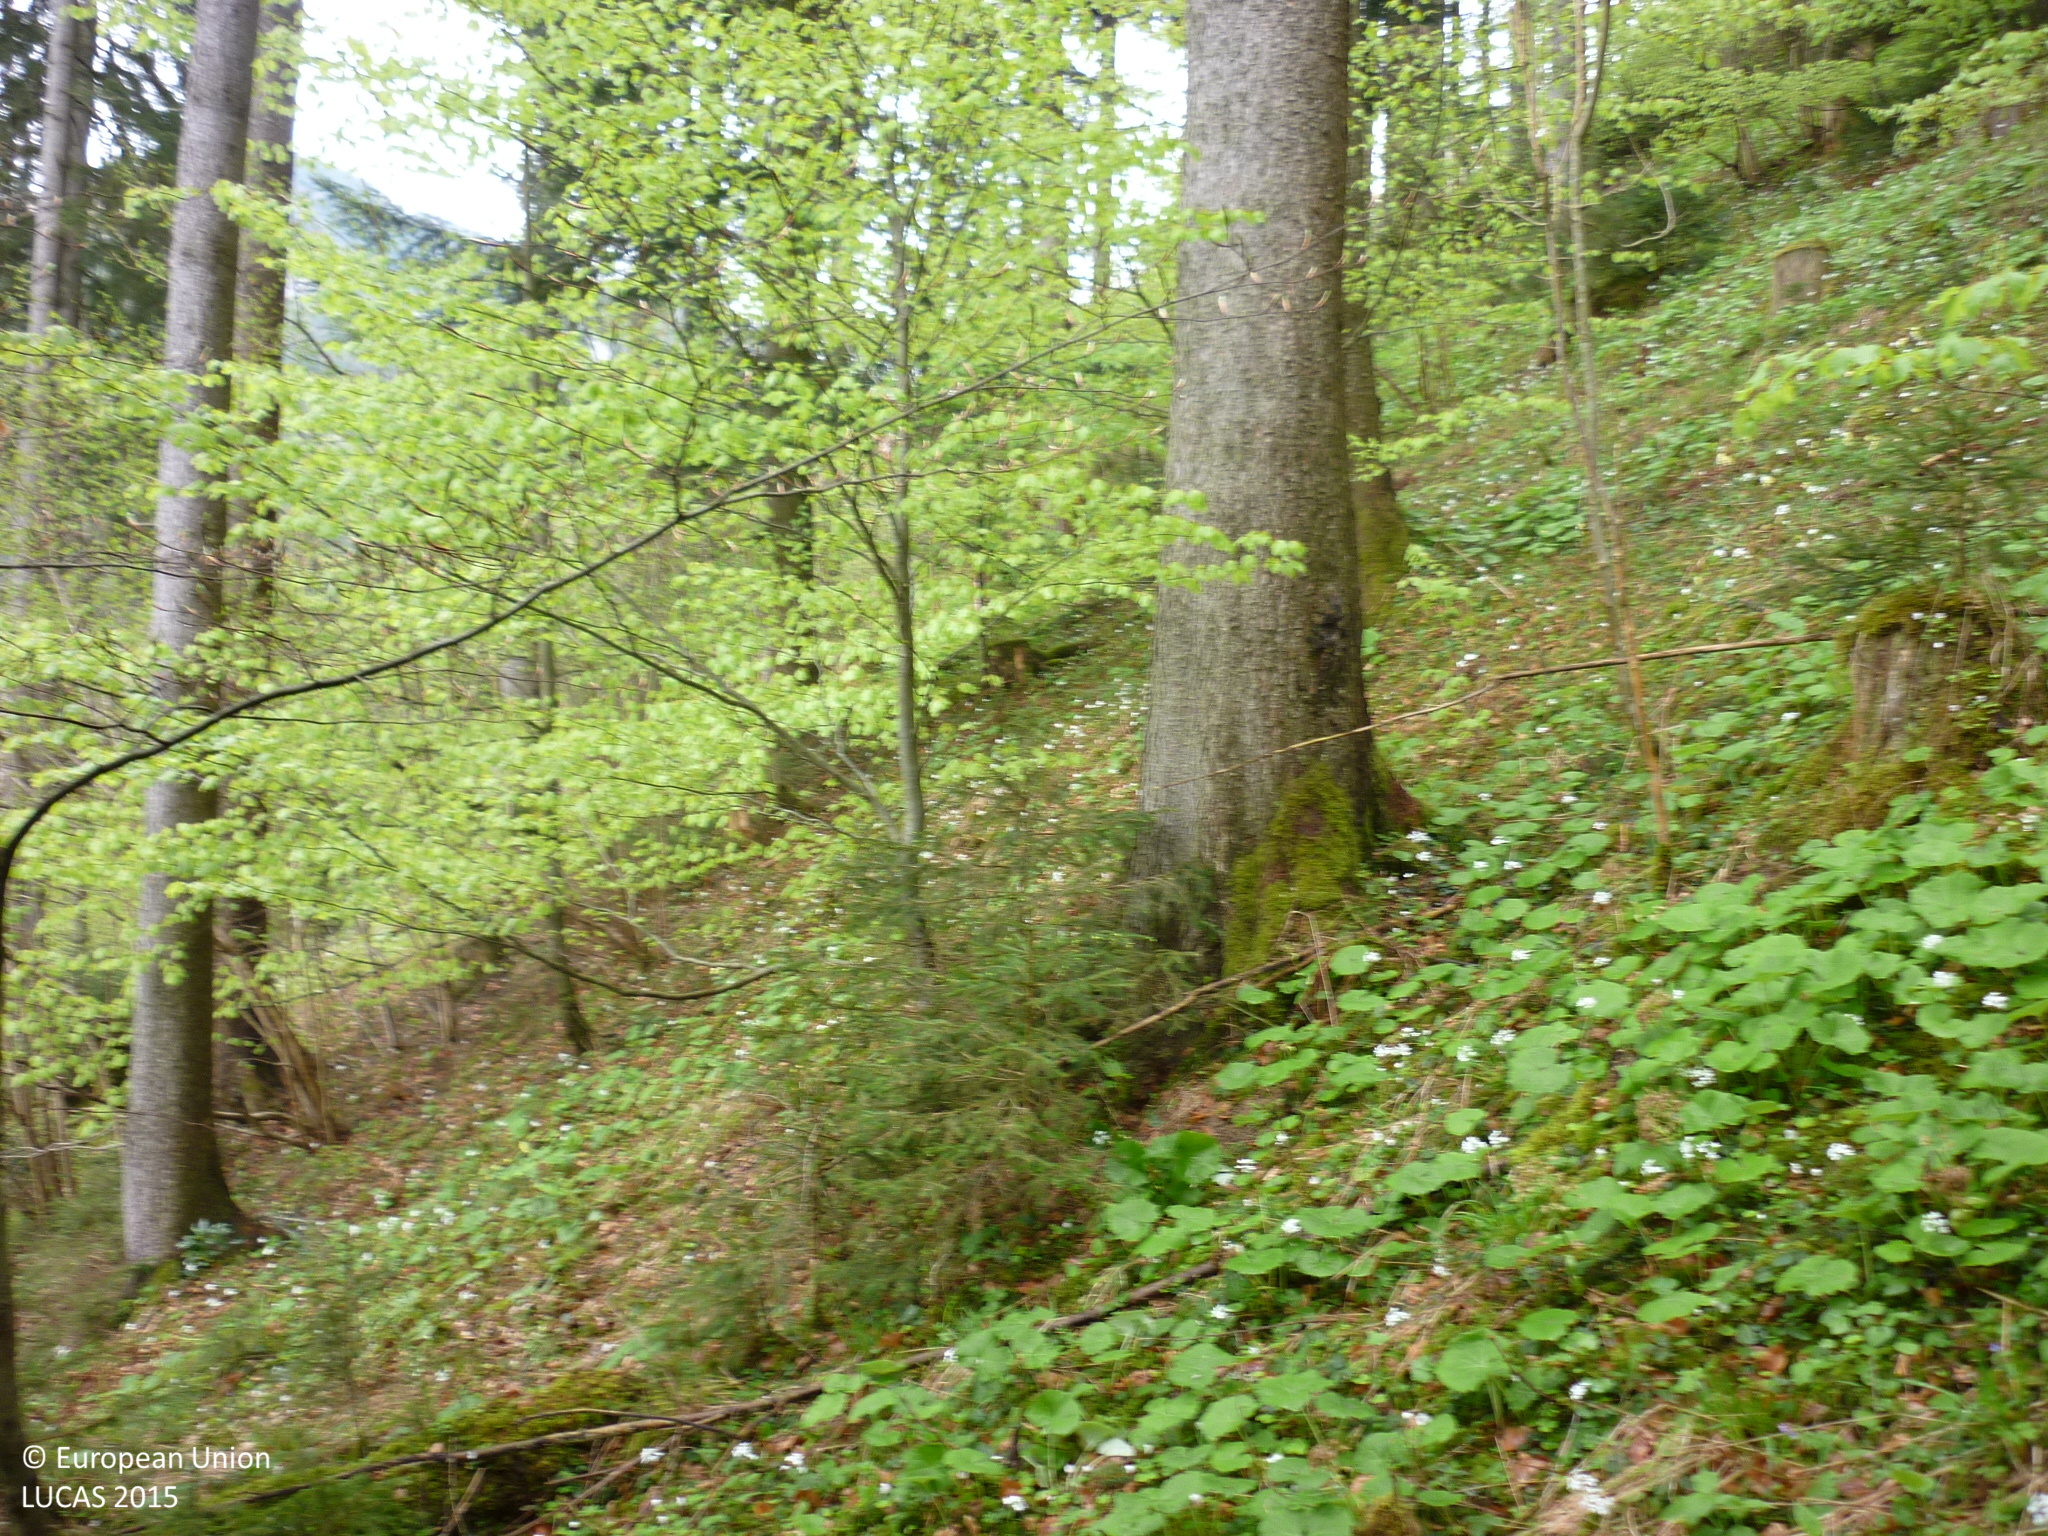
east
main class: Woodland
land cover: Spruce dominated mixed woodland
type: alpine coniferous forest
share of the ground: > 75 %
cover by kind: coniferous forest trees 60 %, broadleaved forest trees 30 %, herbaceous plants 5 %, lichens and mosses 5 %
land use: Forestry
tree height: > 5 m
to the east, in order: Spruce dominated mixed woodland; Broadleaved woodland; Spruce dominated mixed woodland
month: May
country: AT
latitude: 47.7276
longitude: 14.6796
